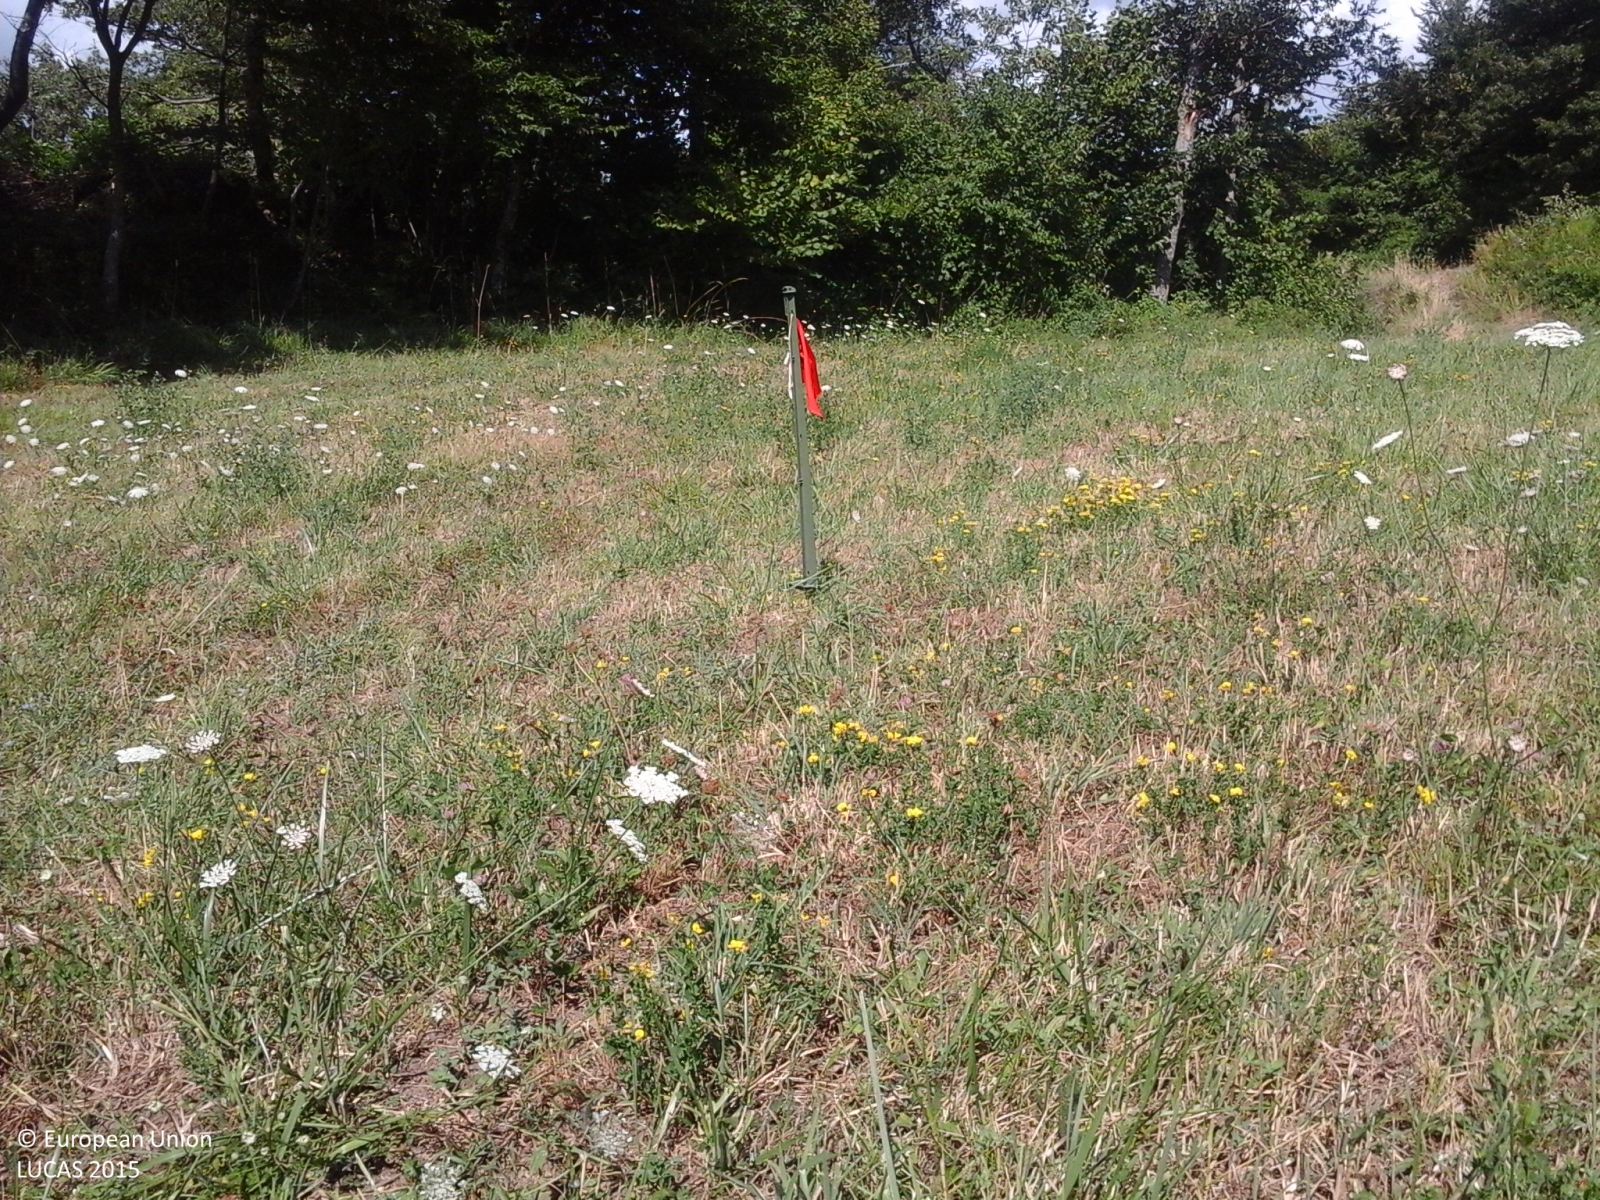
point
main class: Grassland
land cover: Grassland without tree/shrub cover
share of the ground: > 75 %
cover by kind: herbaceous plants 100 %
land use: Agriculture (excluding fallow land and kitchen gardens)
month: July
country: IT
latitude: 43.7669
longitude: 12.2428
